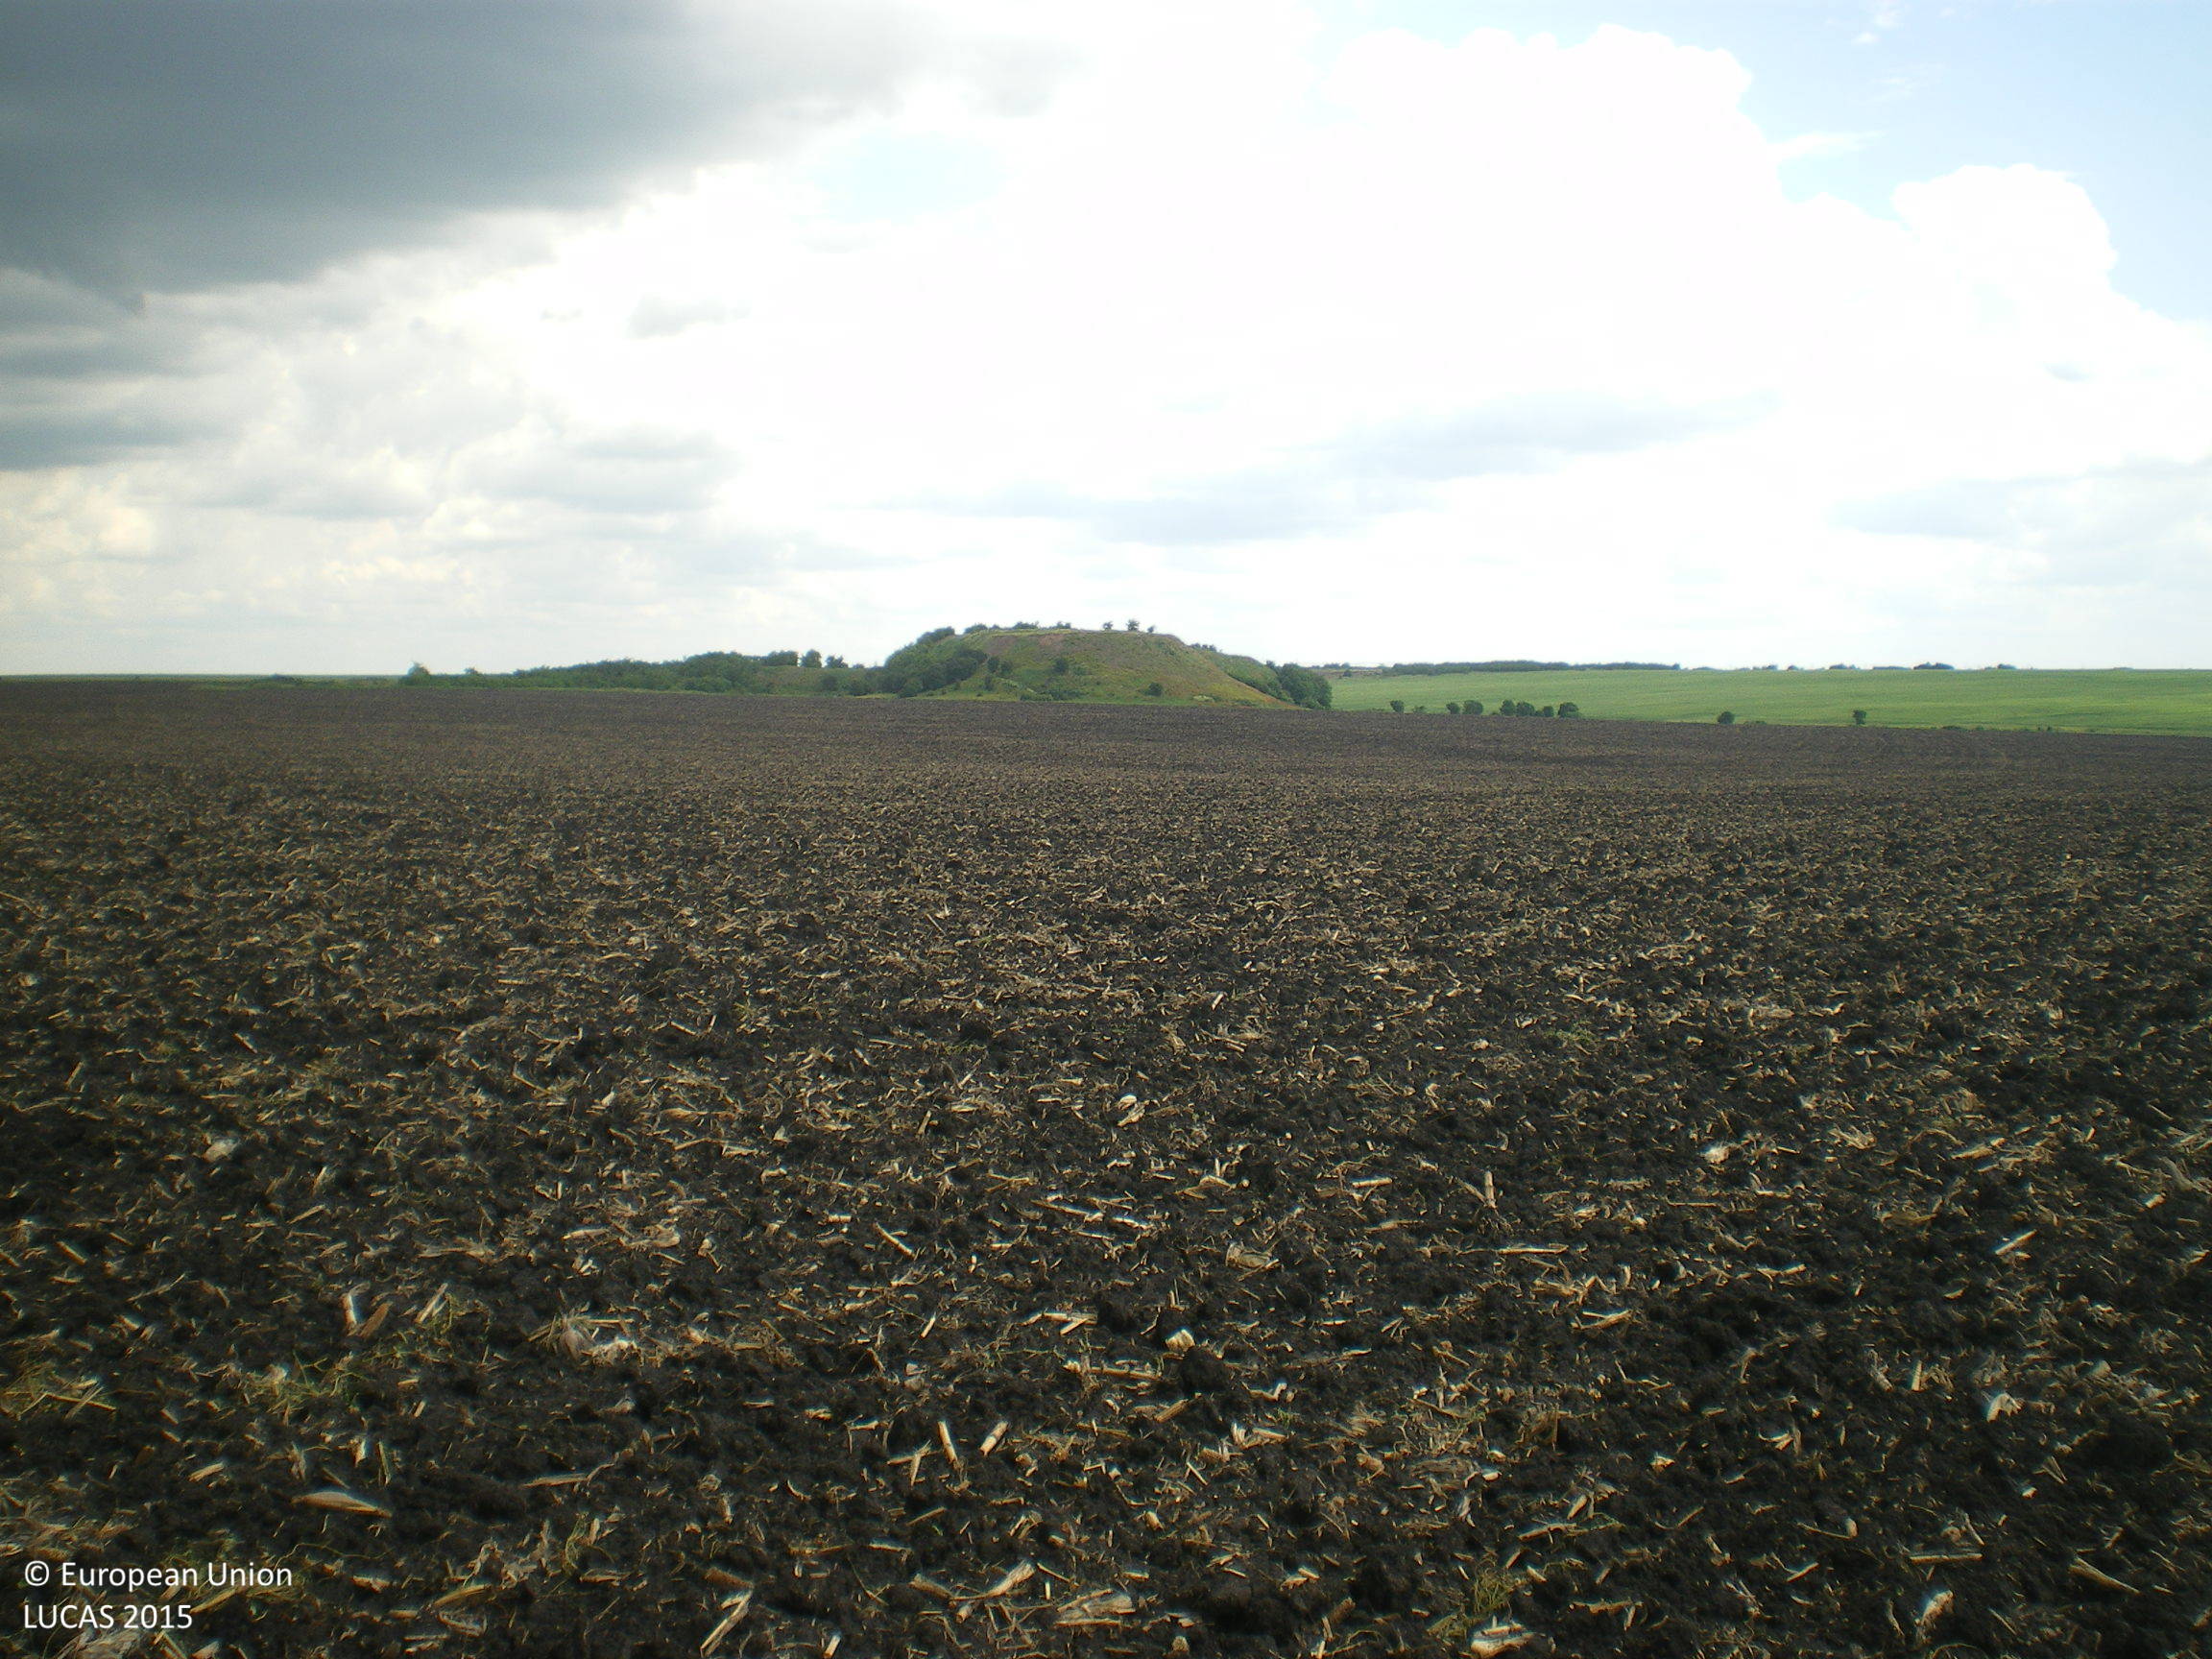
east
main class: Cropland
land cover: Maize
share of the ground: < 10 %
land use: Agriculture (excluding fallow land and kitchen gardens)
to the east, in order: Maize
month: May
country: BG
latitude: 42.1683
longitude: 25.4996
